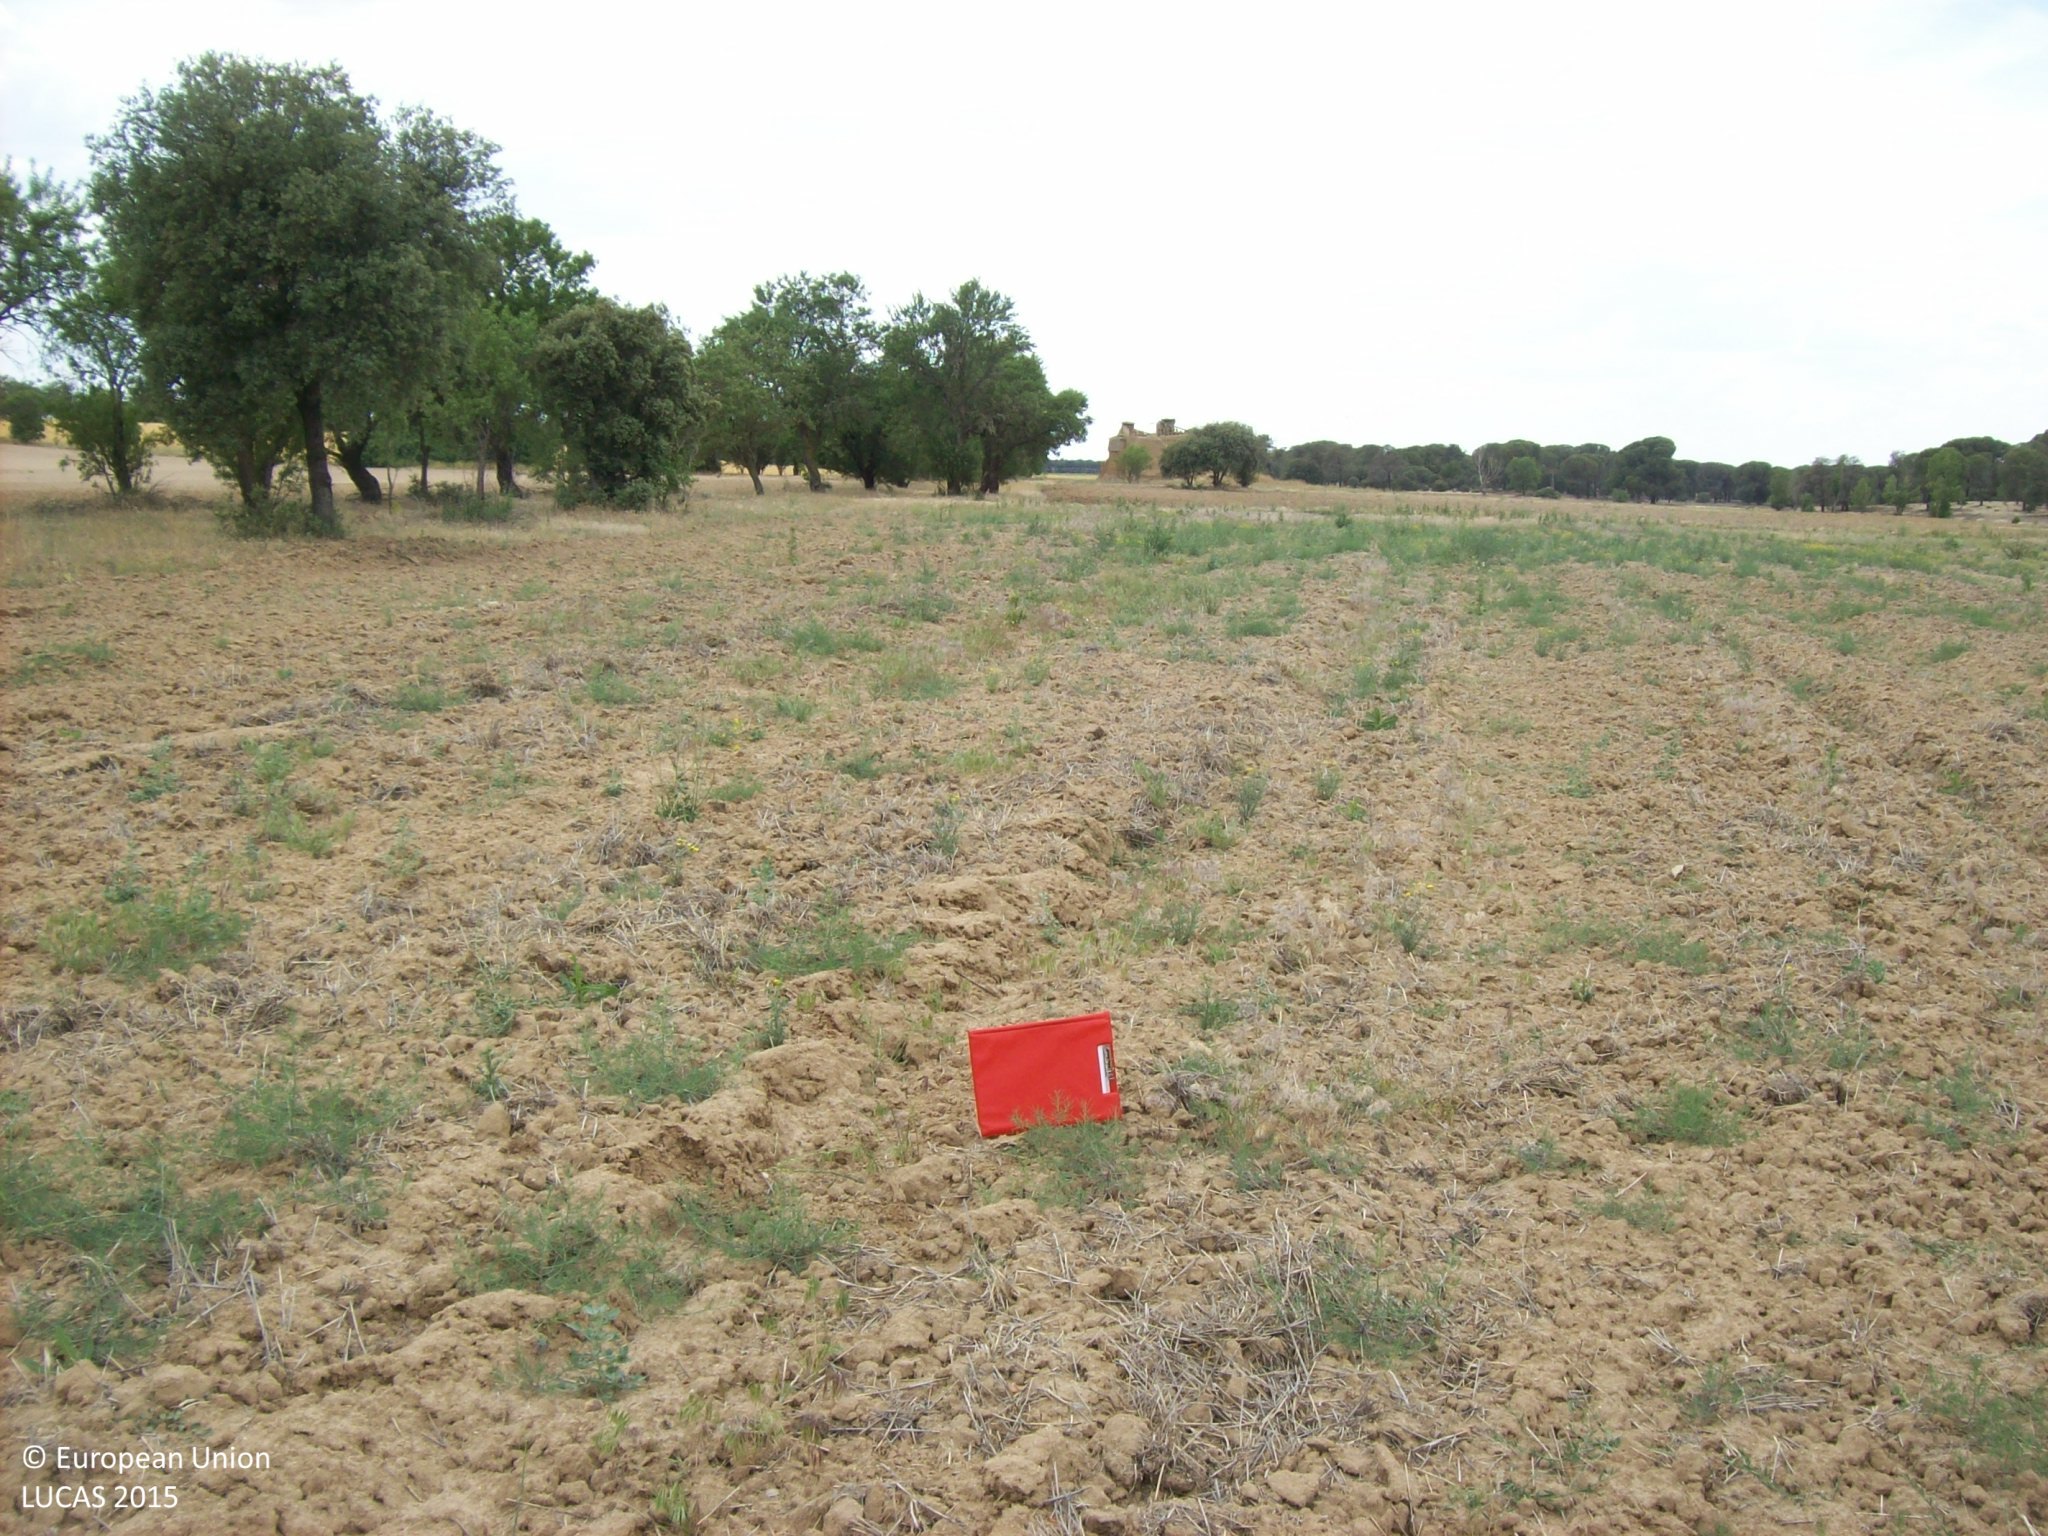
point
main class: Grassland
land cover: Spontaneously vegetated surfaces
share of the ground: 10 - 25 %
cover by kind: unconsolidated bare surface 85 %, herbaceous plants 15 %
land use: Fallow land
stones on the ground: < 10 %
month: June
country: ES
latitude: 41.1769
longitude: -5.0284
